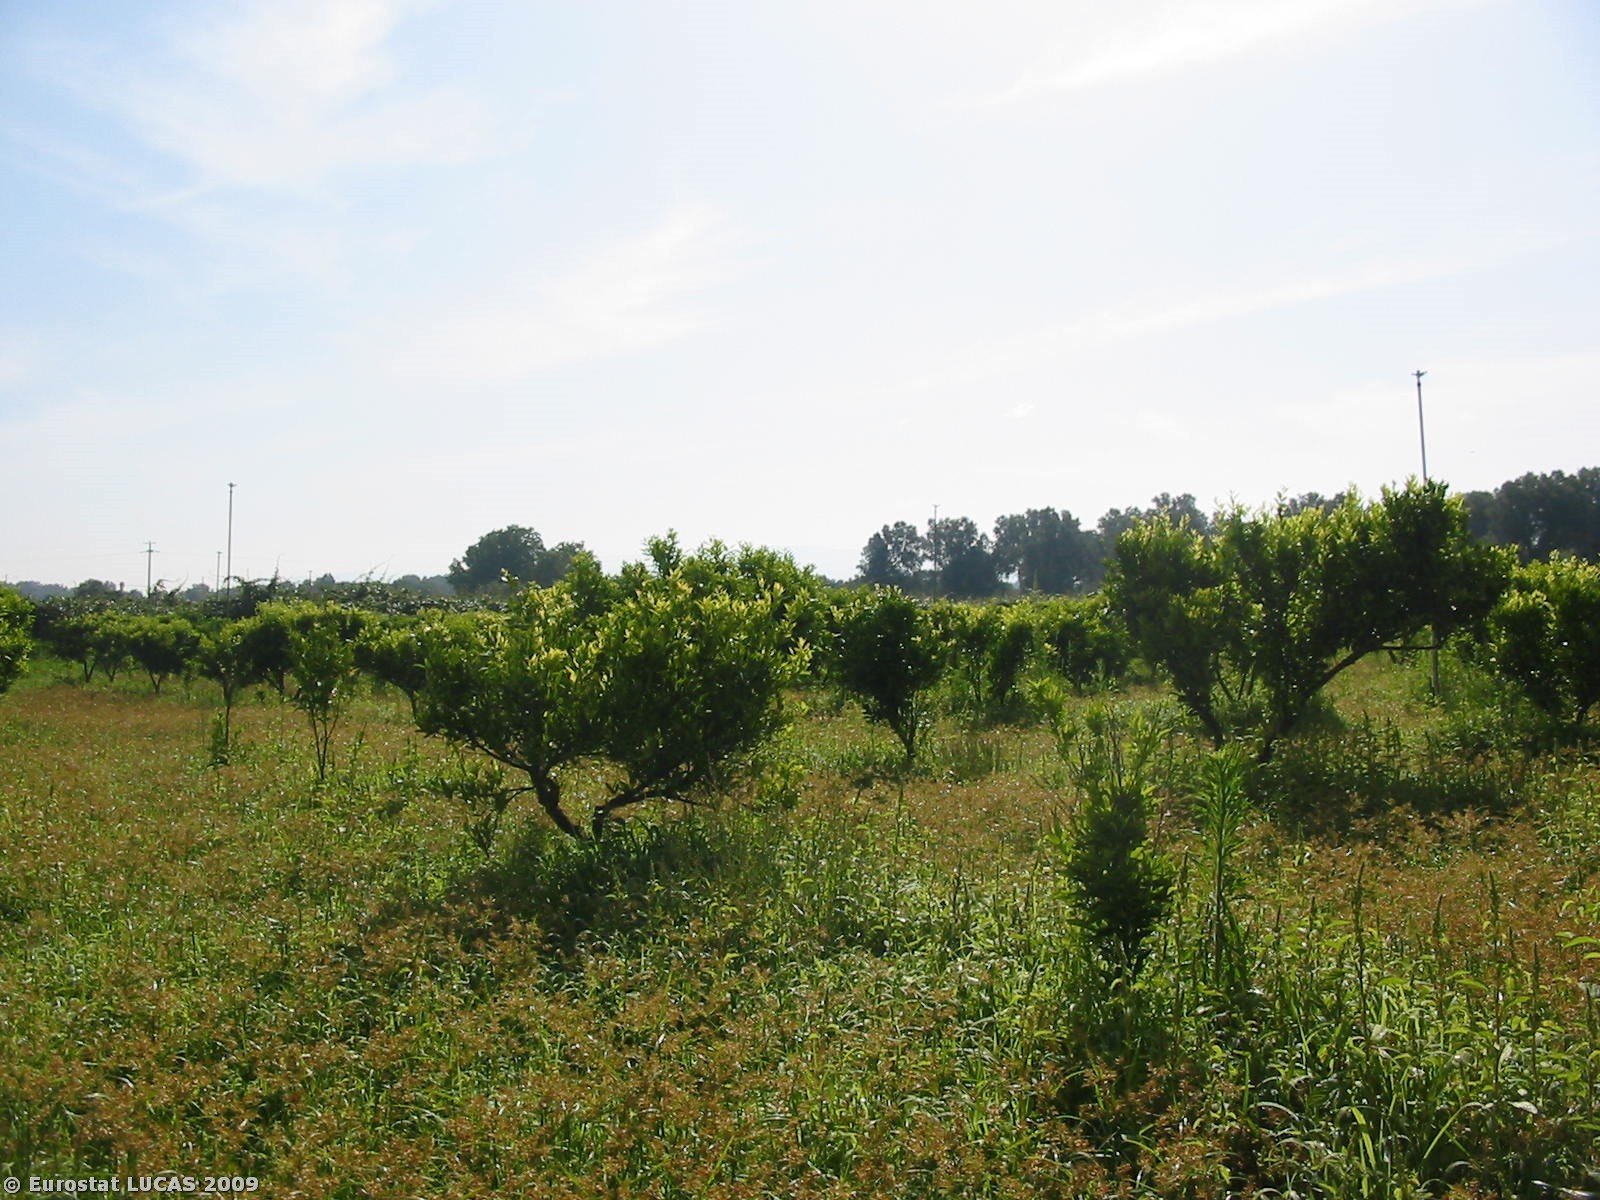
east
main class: Cropland
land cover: Other citrus fruit
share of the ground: 50 - 75 %
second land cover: Spontaneously vegetated surfaces
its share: > 75 %
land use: Agriculture (excluding fallow land and kitchen gardens)
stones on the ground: < 10 %
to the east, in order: Other citrus fruit; Spontaneously vegetated surfaces; Tracks; Other fruit trees and berries; Spontaneously vegetated surfaces; Fences; Olive groves; Spontaneously vegetated surfaces
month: July
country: IT
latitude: 38.4517
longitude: 15.9580
